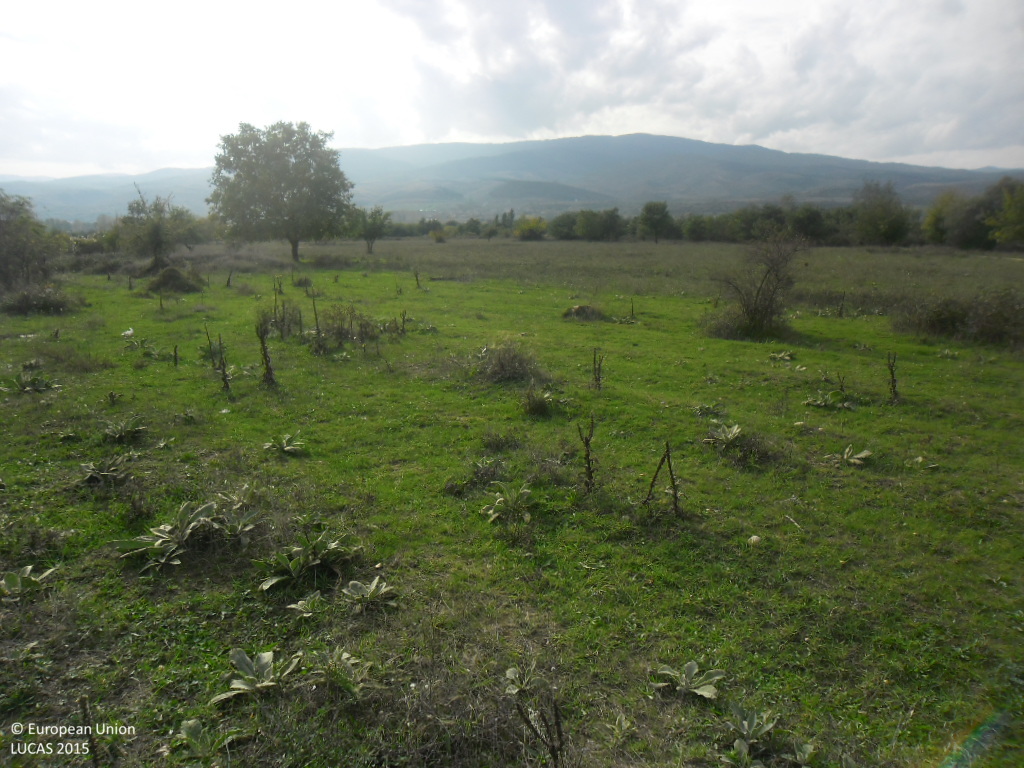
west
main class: Grassland
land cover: Grassland with sparse tree/shrub cover
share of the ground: > 75 %
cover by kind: herbaceous plants 90 %, broadleaved forest trees 5 %, shrubs 5 %
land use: Agriculture (excluding fallow land and kitchen gardens)
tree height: < 5 m
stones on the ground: < 10 %
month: October
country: BG
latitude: 42.0985
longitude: 23.0469
